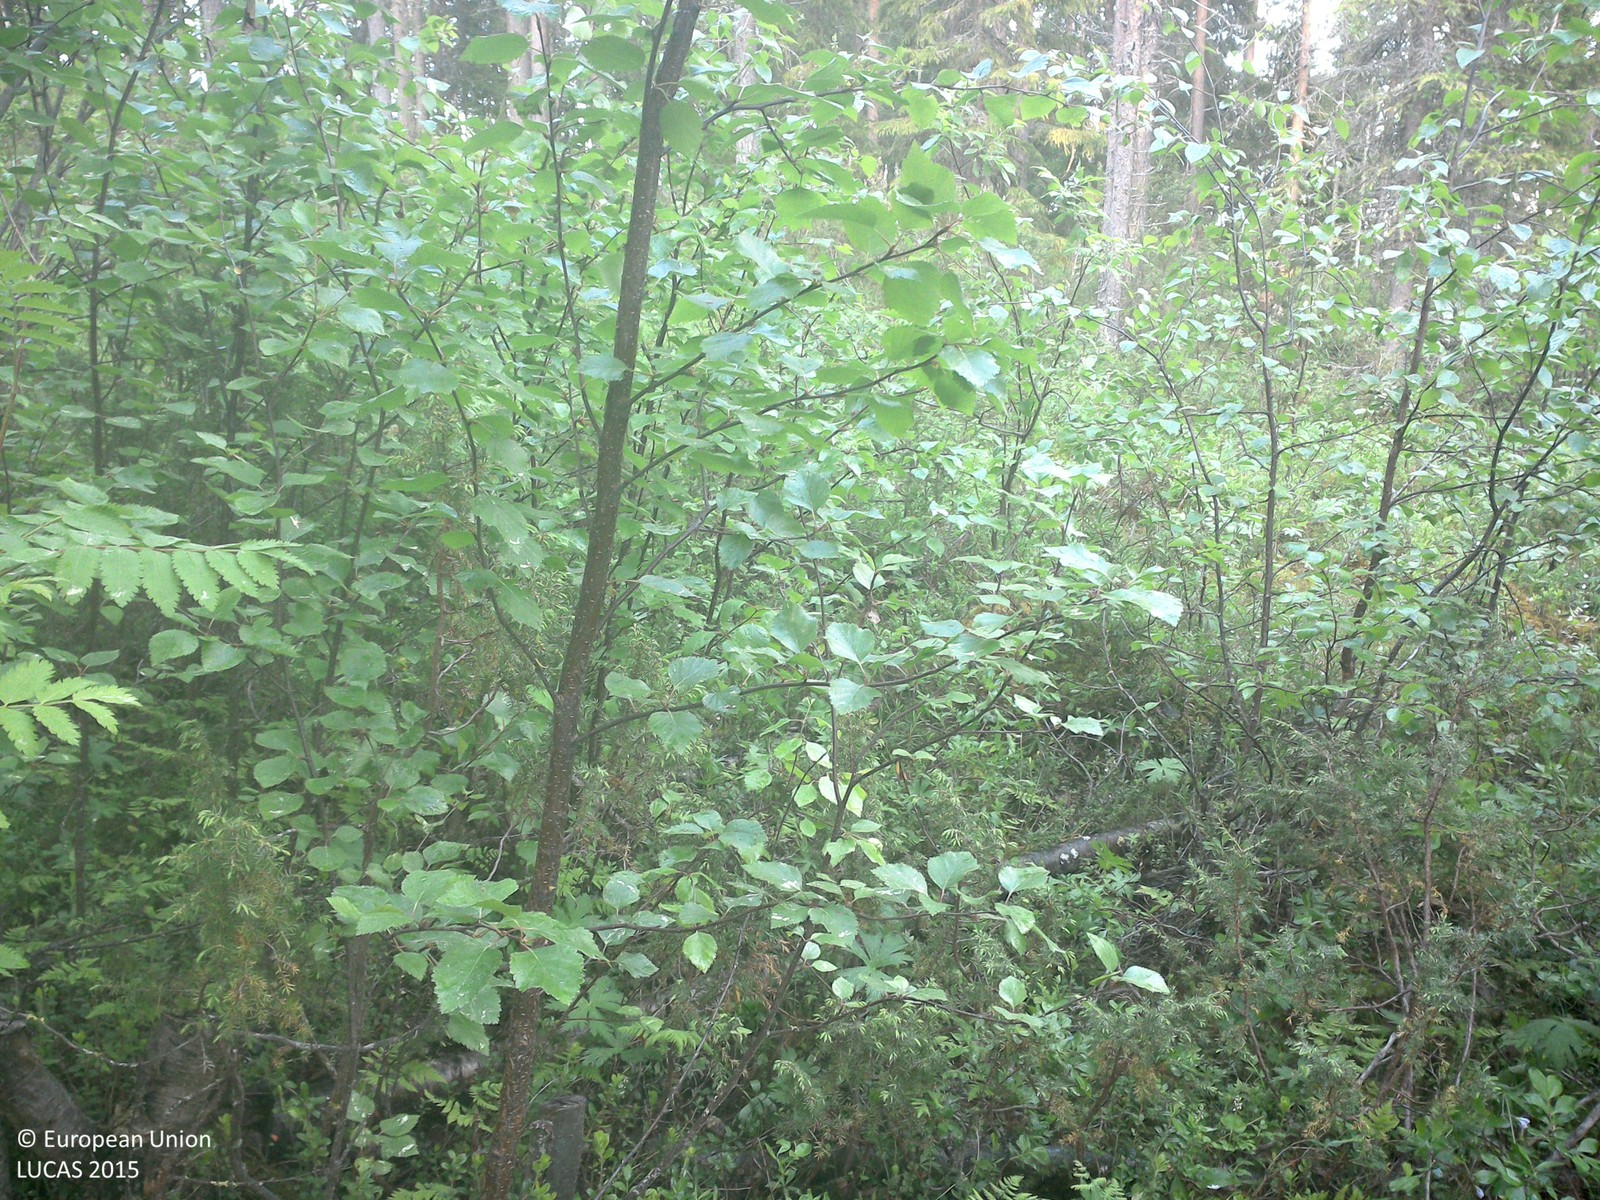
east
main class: Woodland
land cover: Pine dominated mixed woodland
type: boreal forest
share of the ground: 25 - 50 %
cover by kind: shrubs 60 %, coniferous forest trees 20 %, broadleaved forest trees 10 %, herbaceous plants 5 %, lichens and mosses 5 %
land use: Forestry
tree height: > 5 m
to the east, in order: Pine dominated mixed woodland; Broadleaved woodland; Pine dominated coniferous woodland; Pine dominated mixed woodland; Grass margins; Pine dominated mixed woodland; Grassland without tree/shrub cover; Paved roads, cycling and walking lanes; Grassland without tree/shrub cover
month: July
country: SE
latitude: 66.9184
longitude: 23.1626
